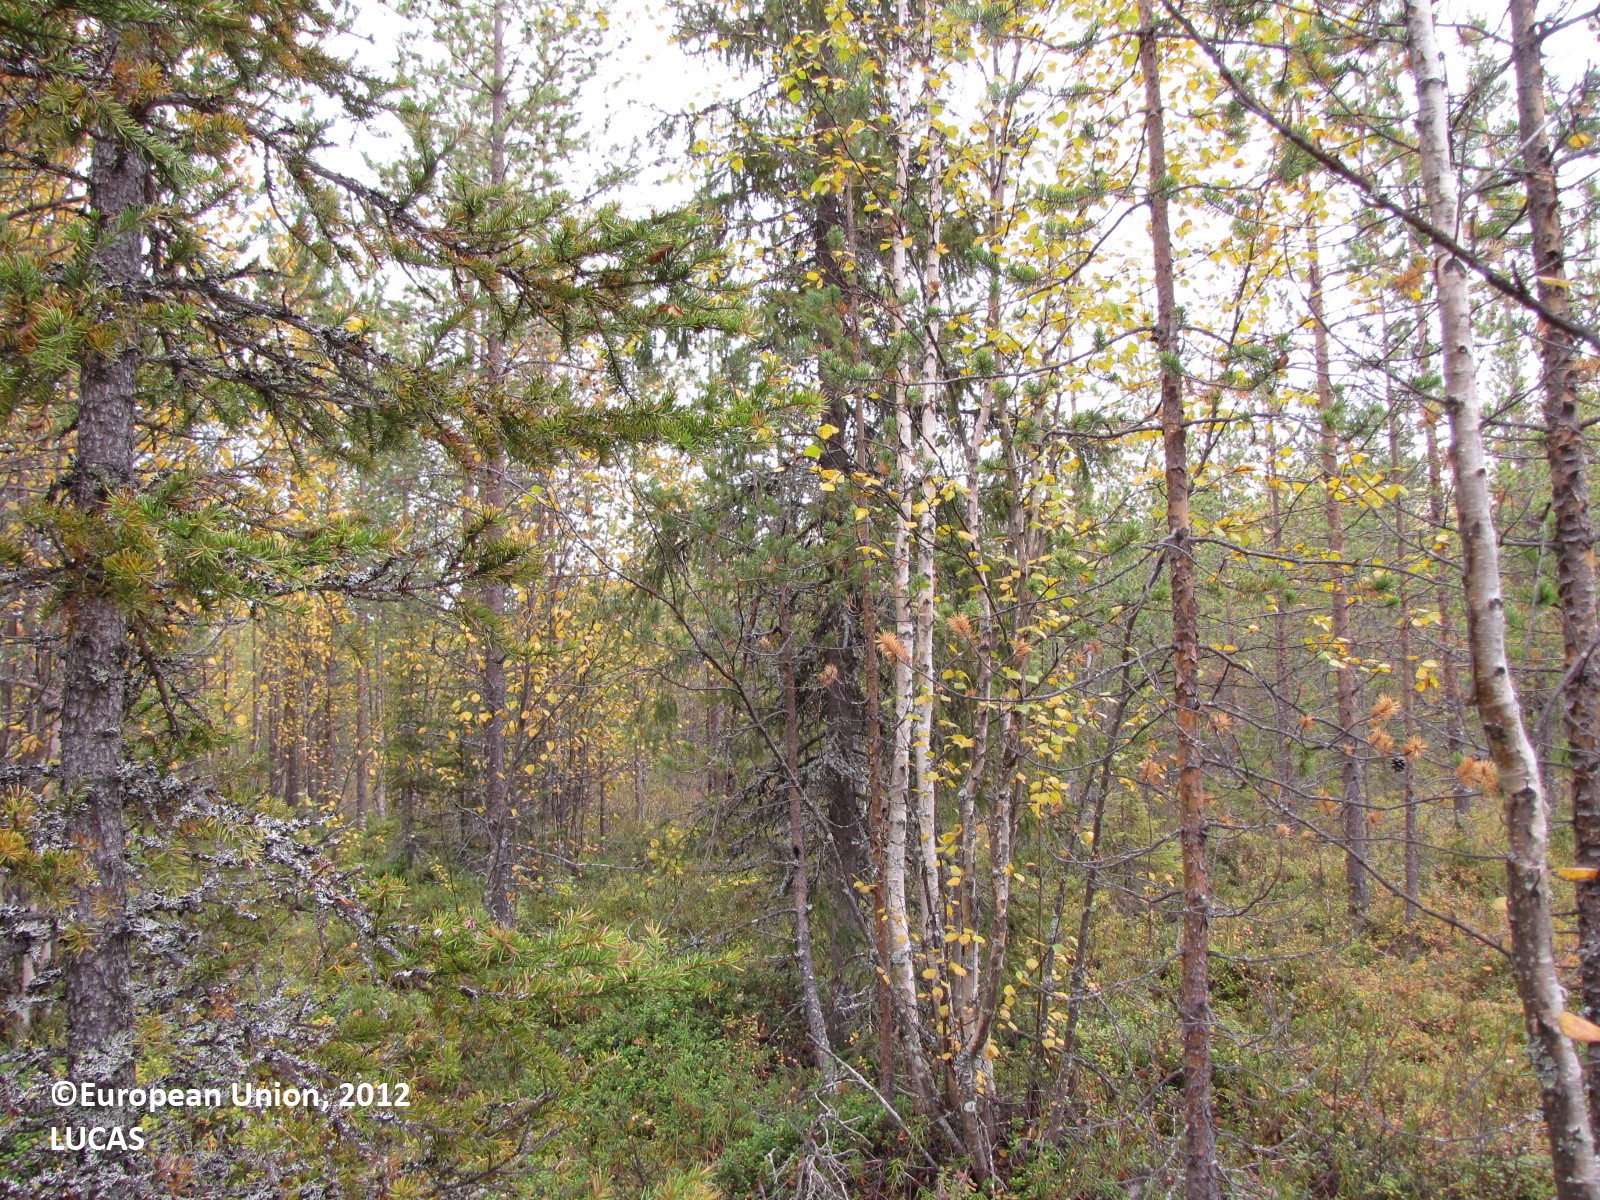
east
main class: Woodland
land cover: Pine dominated mixed woodland
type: boreal forest
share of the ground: 25 - 50 %
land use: Forestry
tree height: > 5 m
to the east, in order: Pine dominated mixed woodland; Ditches and canals; Pine dominated mixed woodland; Ditches and canals; Pine dominated mixed woodland; Ditches and canals; Pine dominated mixed woodland; Ditches and canals; Pine dominated mixed woodland
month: September
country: FI
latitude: 67.3572
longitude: 23.9198
